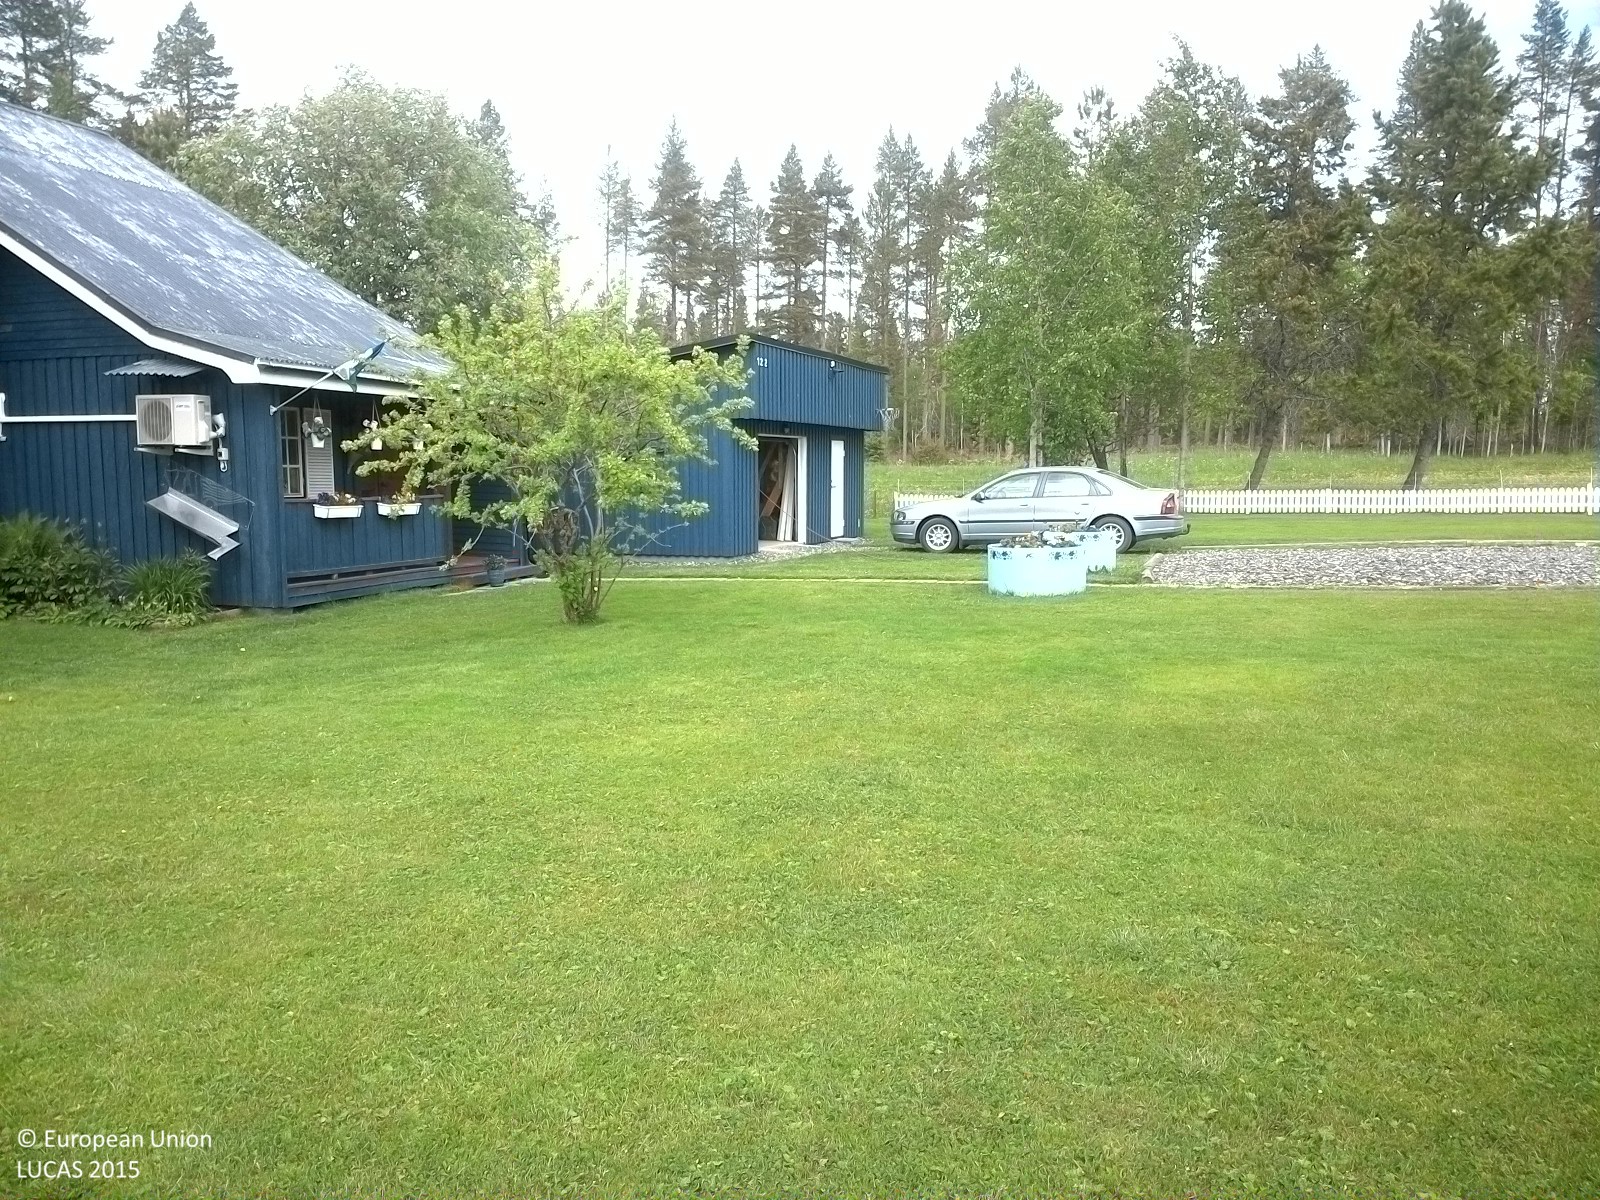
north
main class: Grassland
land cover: Grassland without tree/shrub cover
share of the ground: > 75 %
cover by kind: herbaceous plants 100 %
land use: Residential
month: July
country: SE
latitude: 63.6407
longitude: 14.7205
